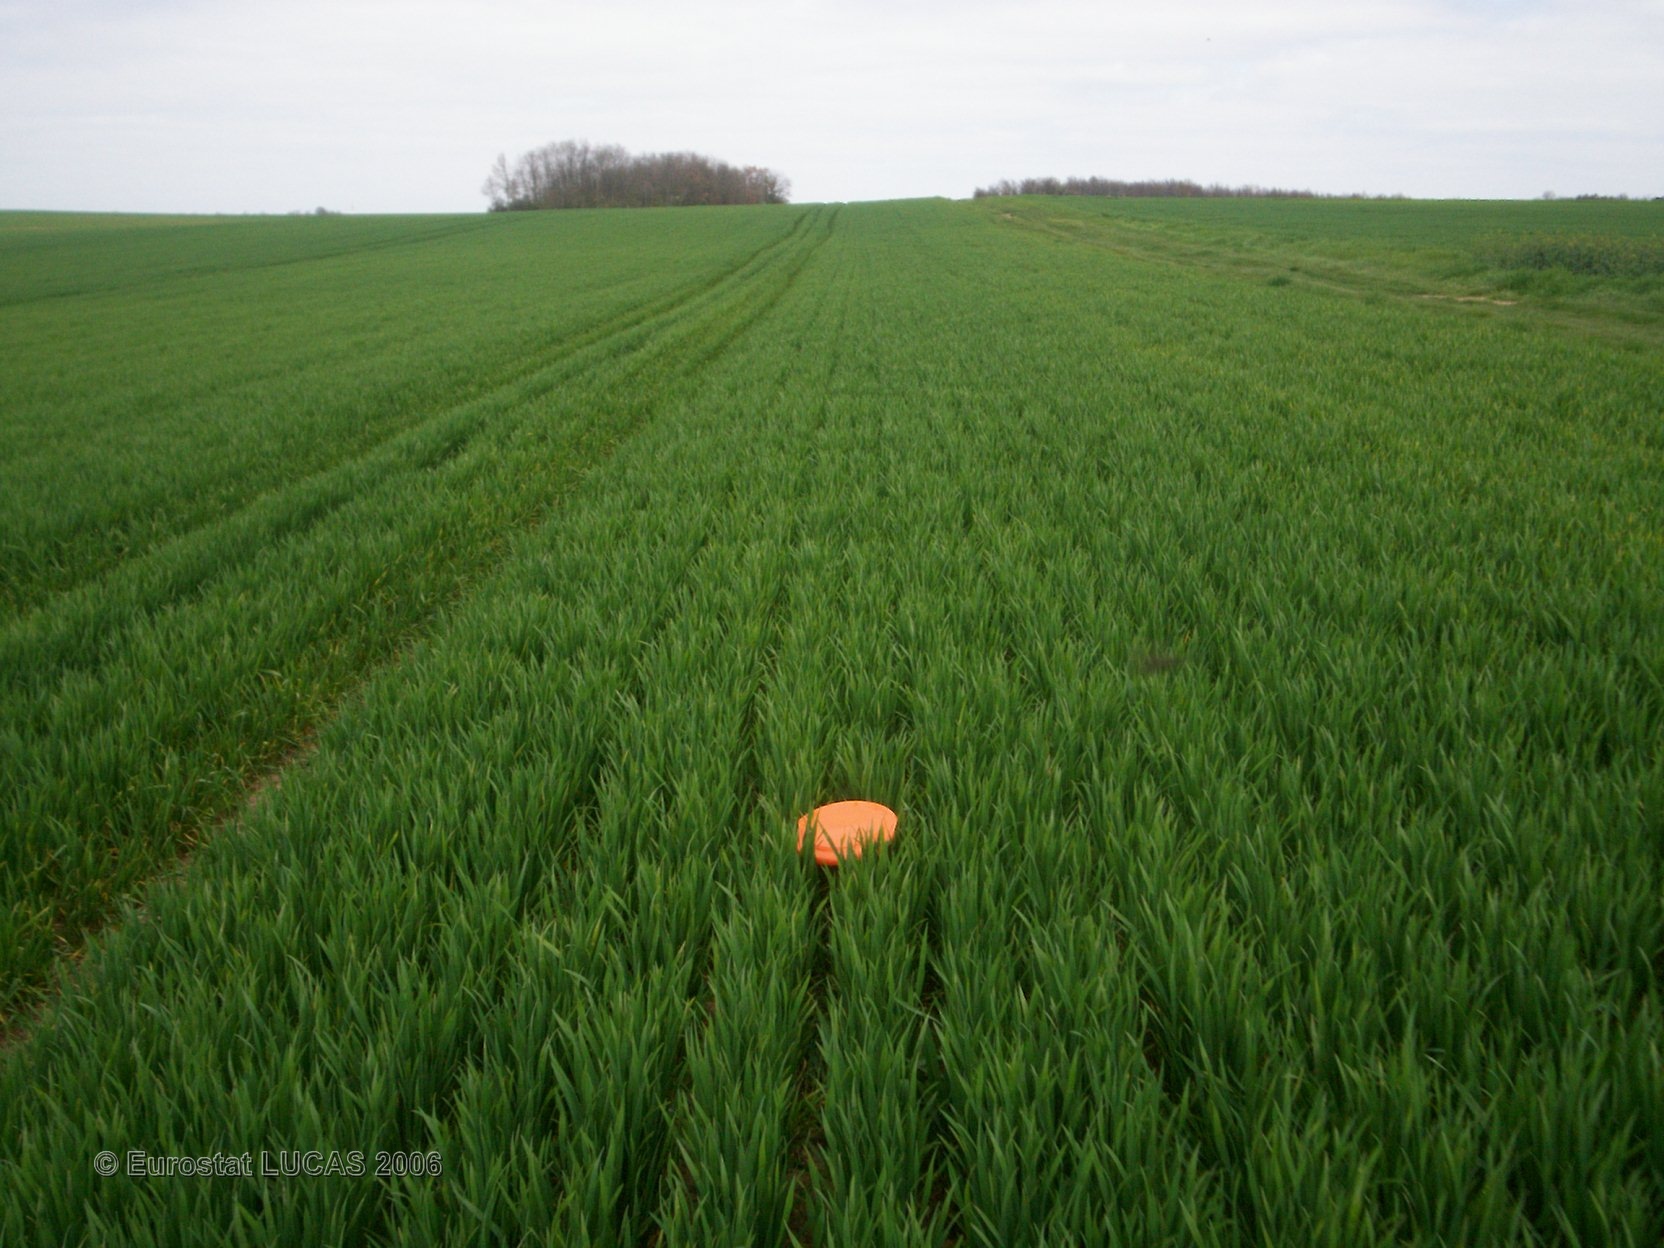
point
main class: Cropland
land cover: Common wheat
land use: Agriculture (excluding fallow land and kitchen gardens)
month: April
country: FR
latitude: 47.1667
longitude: 0.5745
